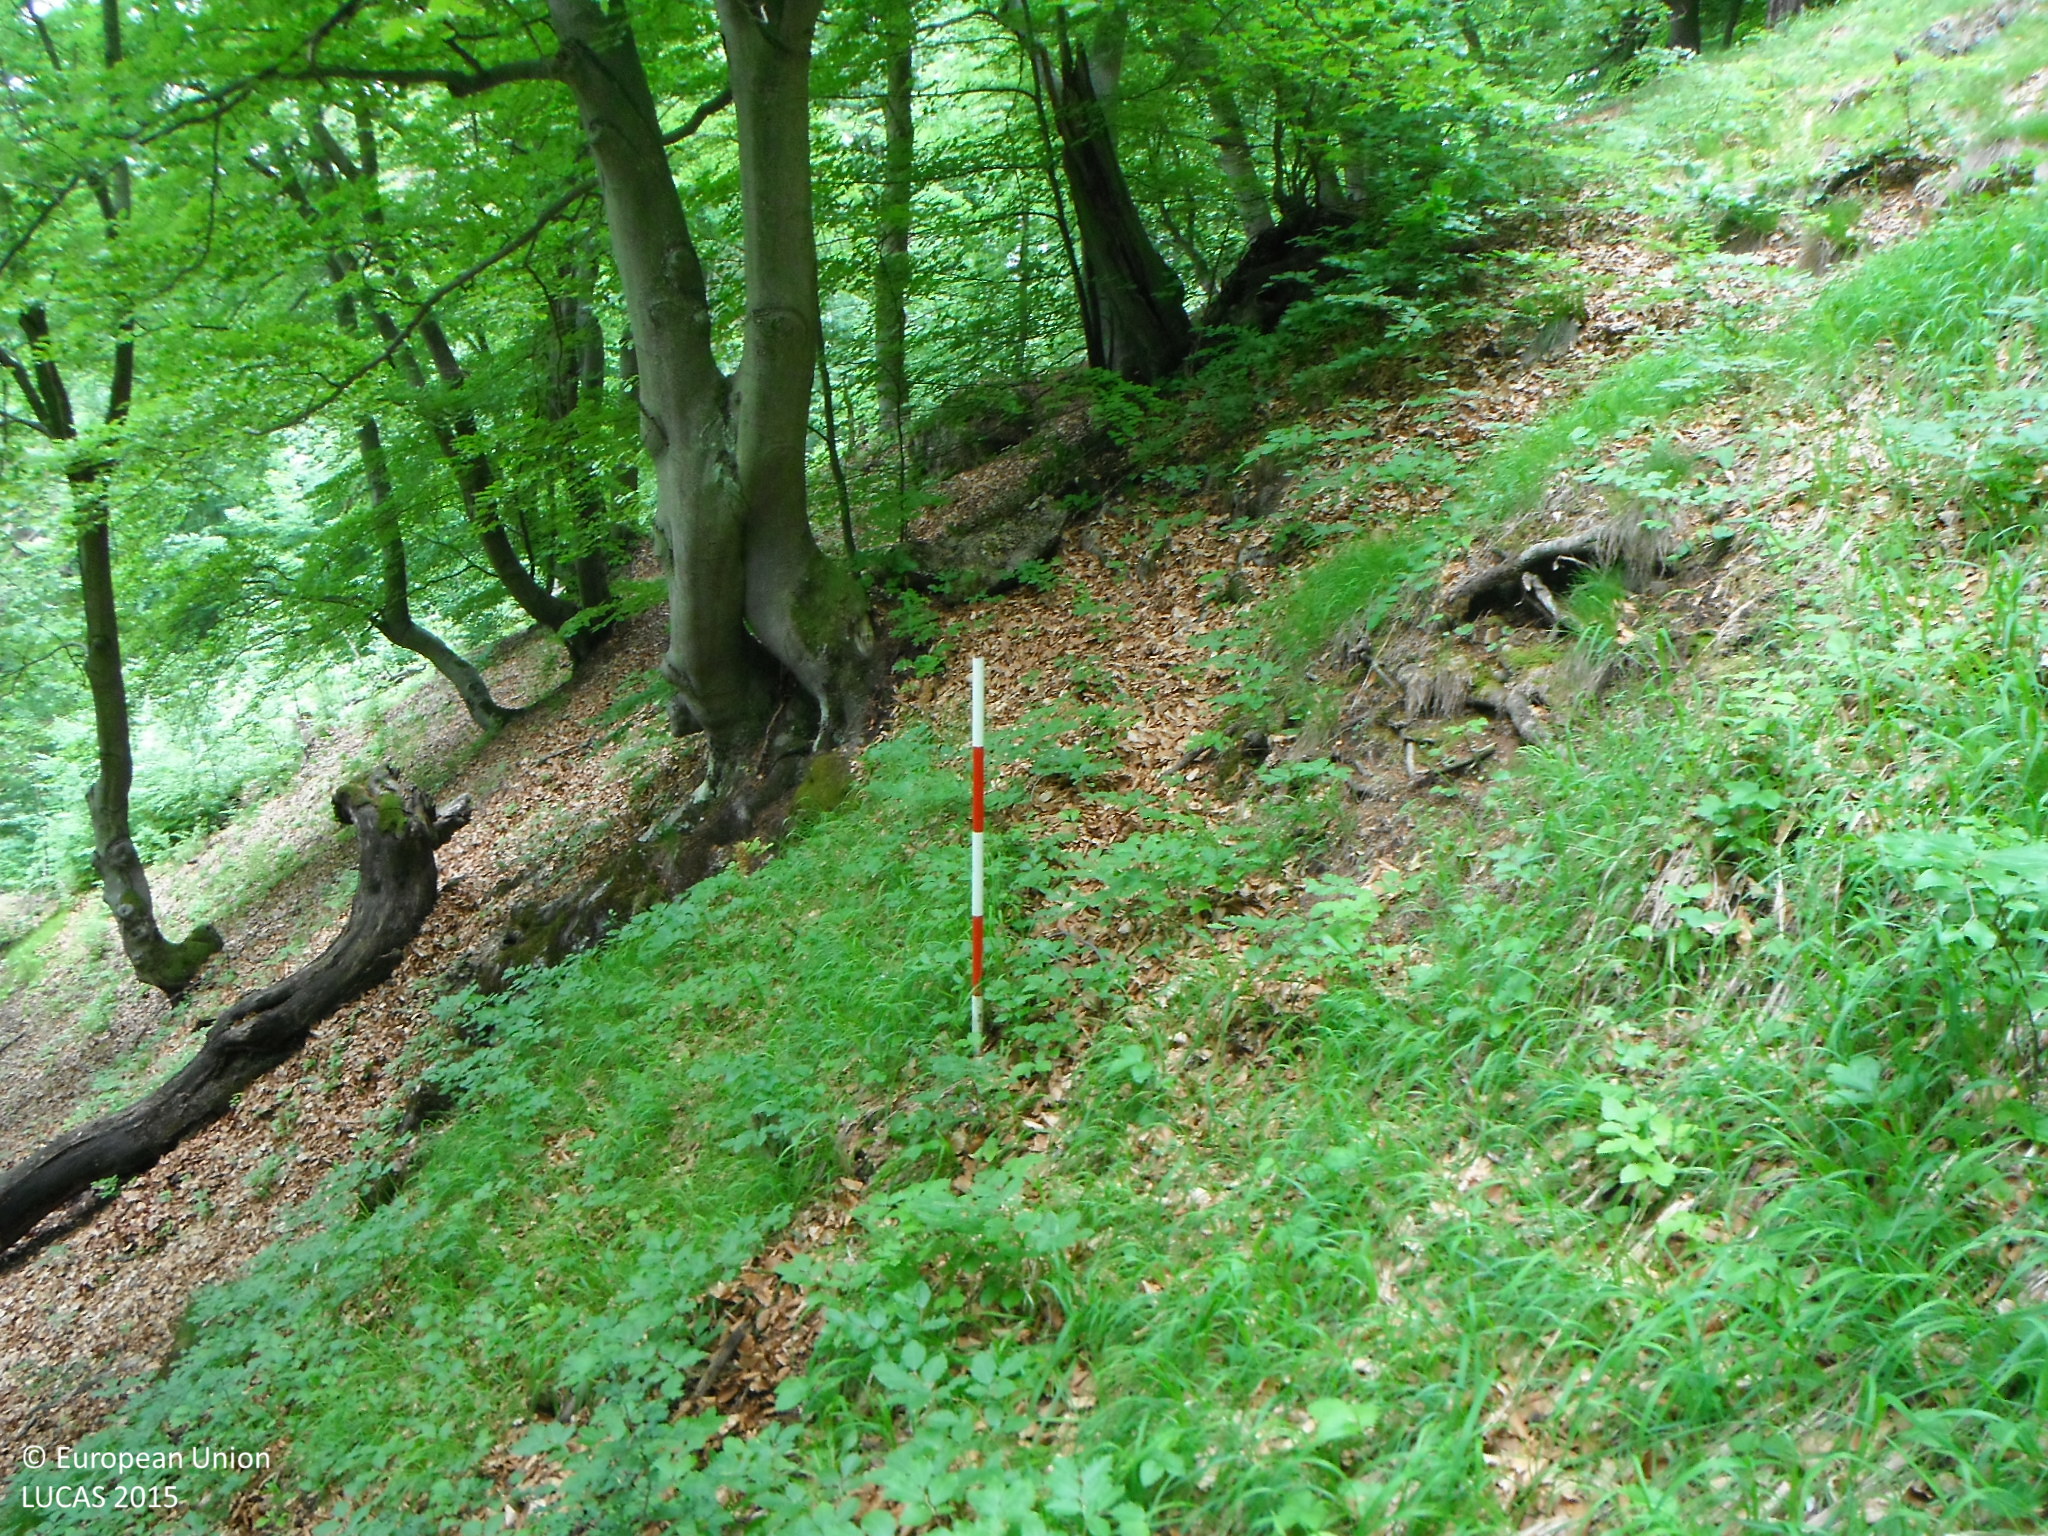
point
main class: Woodland
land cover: Broadleaved woodland
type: mountainous beech forest
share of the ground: > 75 %
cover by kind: broadleaved forest trees 100 %
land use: Forestry
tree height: > 5 m
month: June
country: SK
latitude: 48.8034
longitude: 19.3506
